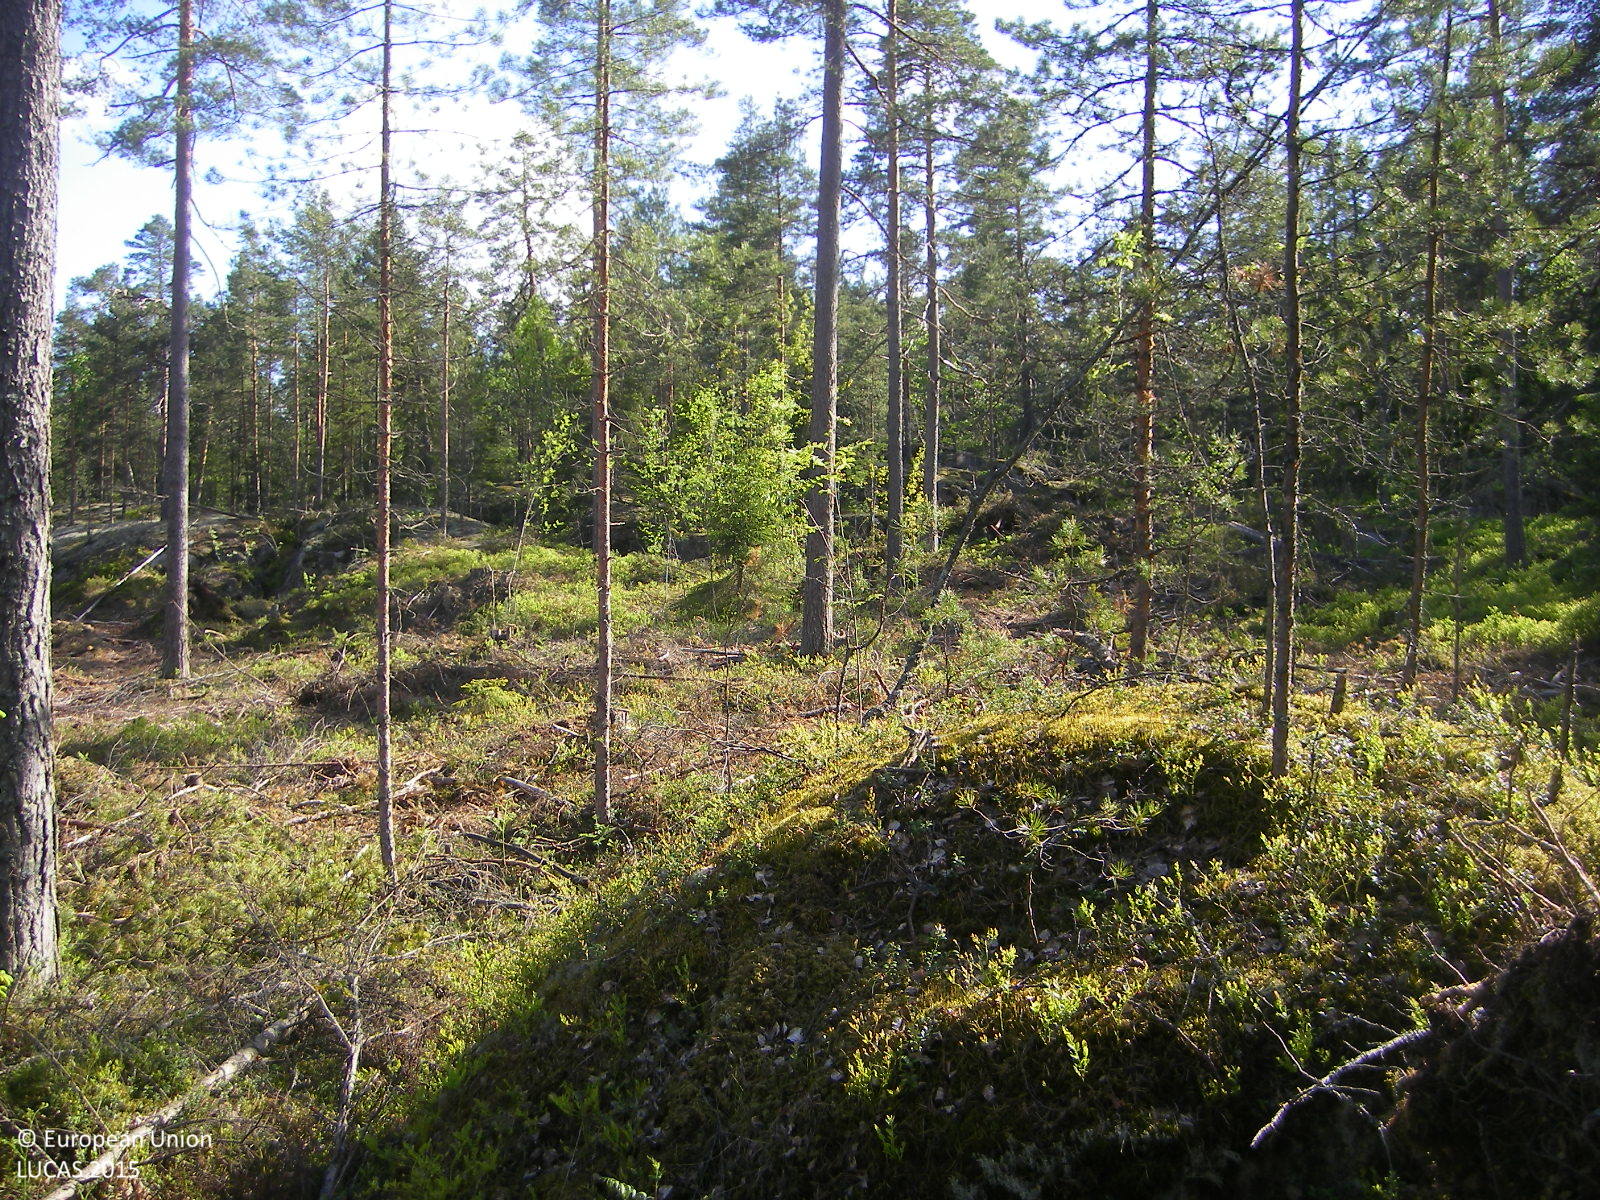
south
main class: Woodland
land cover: Pine dominated coniferous woodland
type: boreal forest
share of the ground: 10 - 25 %
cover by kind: shrubs 45 %, unconsolidated bare surface 35 %, coniferous forest trees 20 %
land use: Forestry
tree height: > 5 m
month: June
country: FI
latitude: 60.2397
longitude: 24.6136
